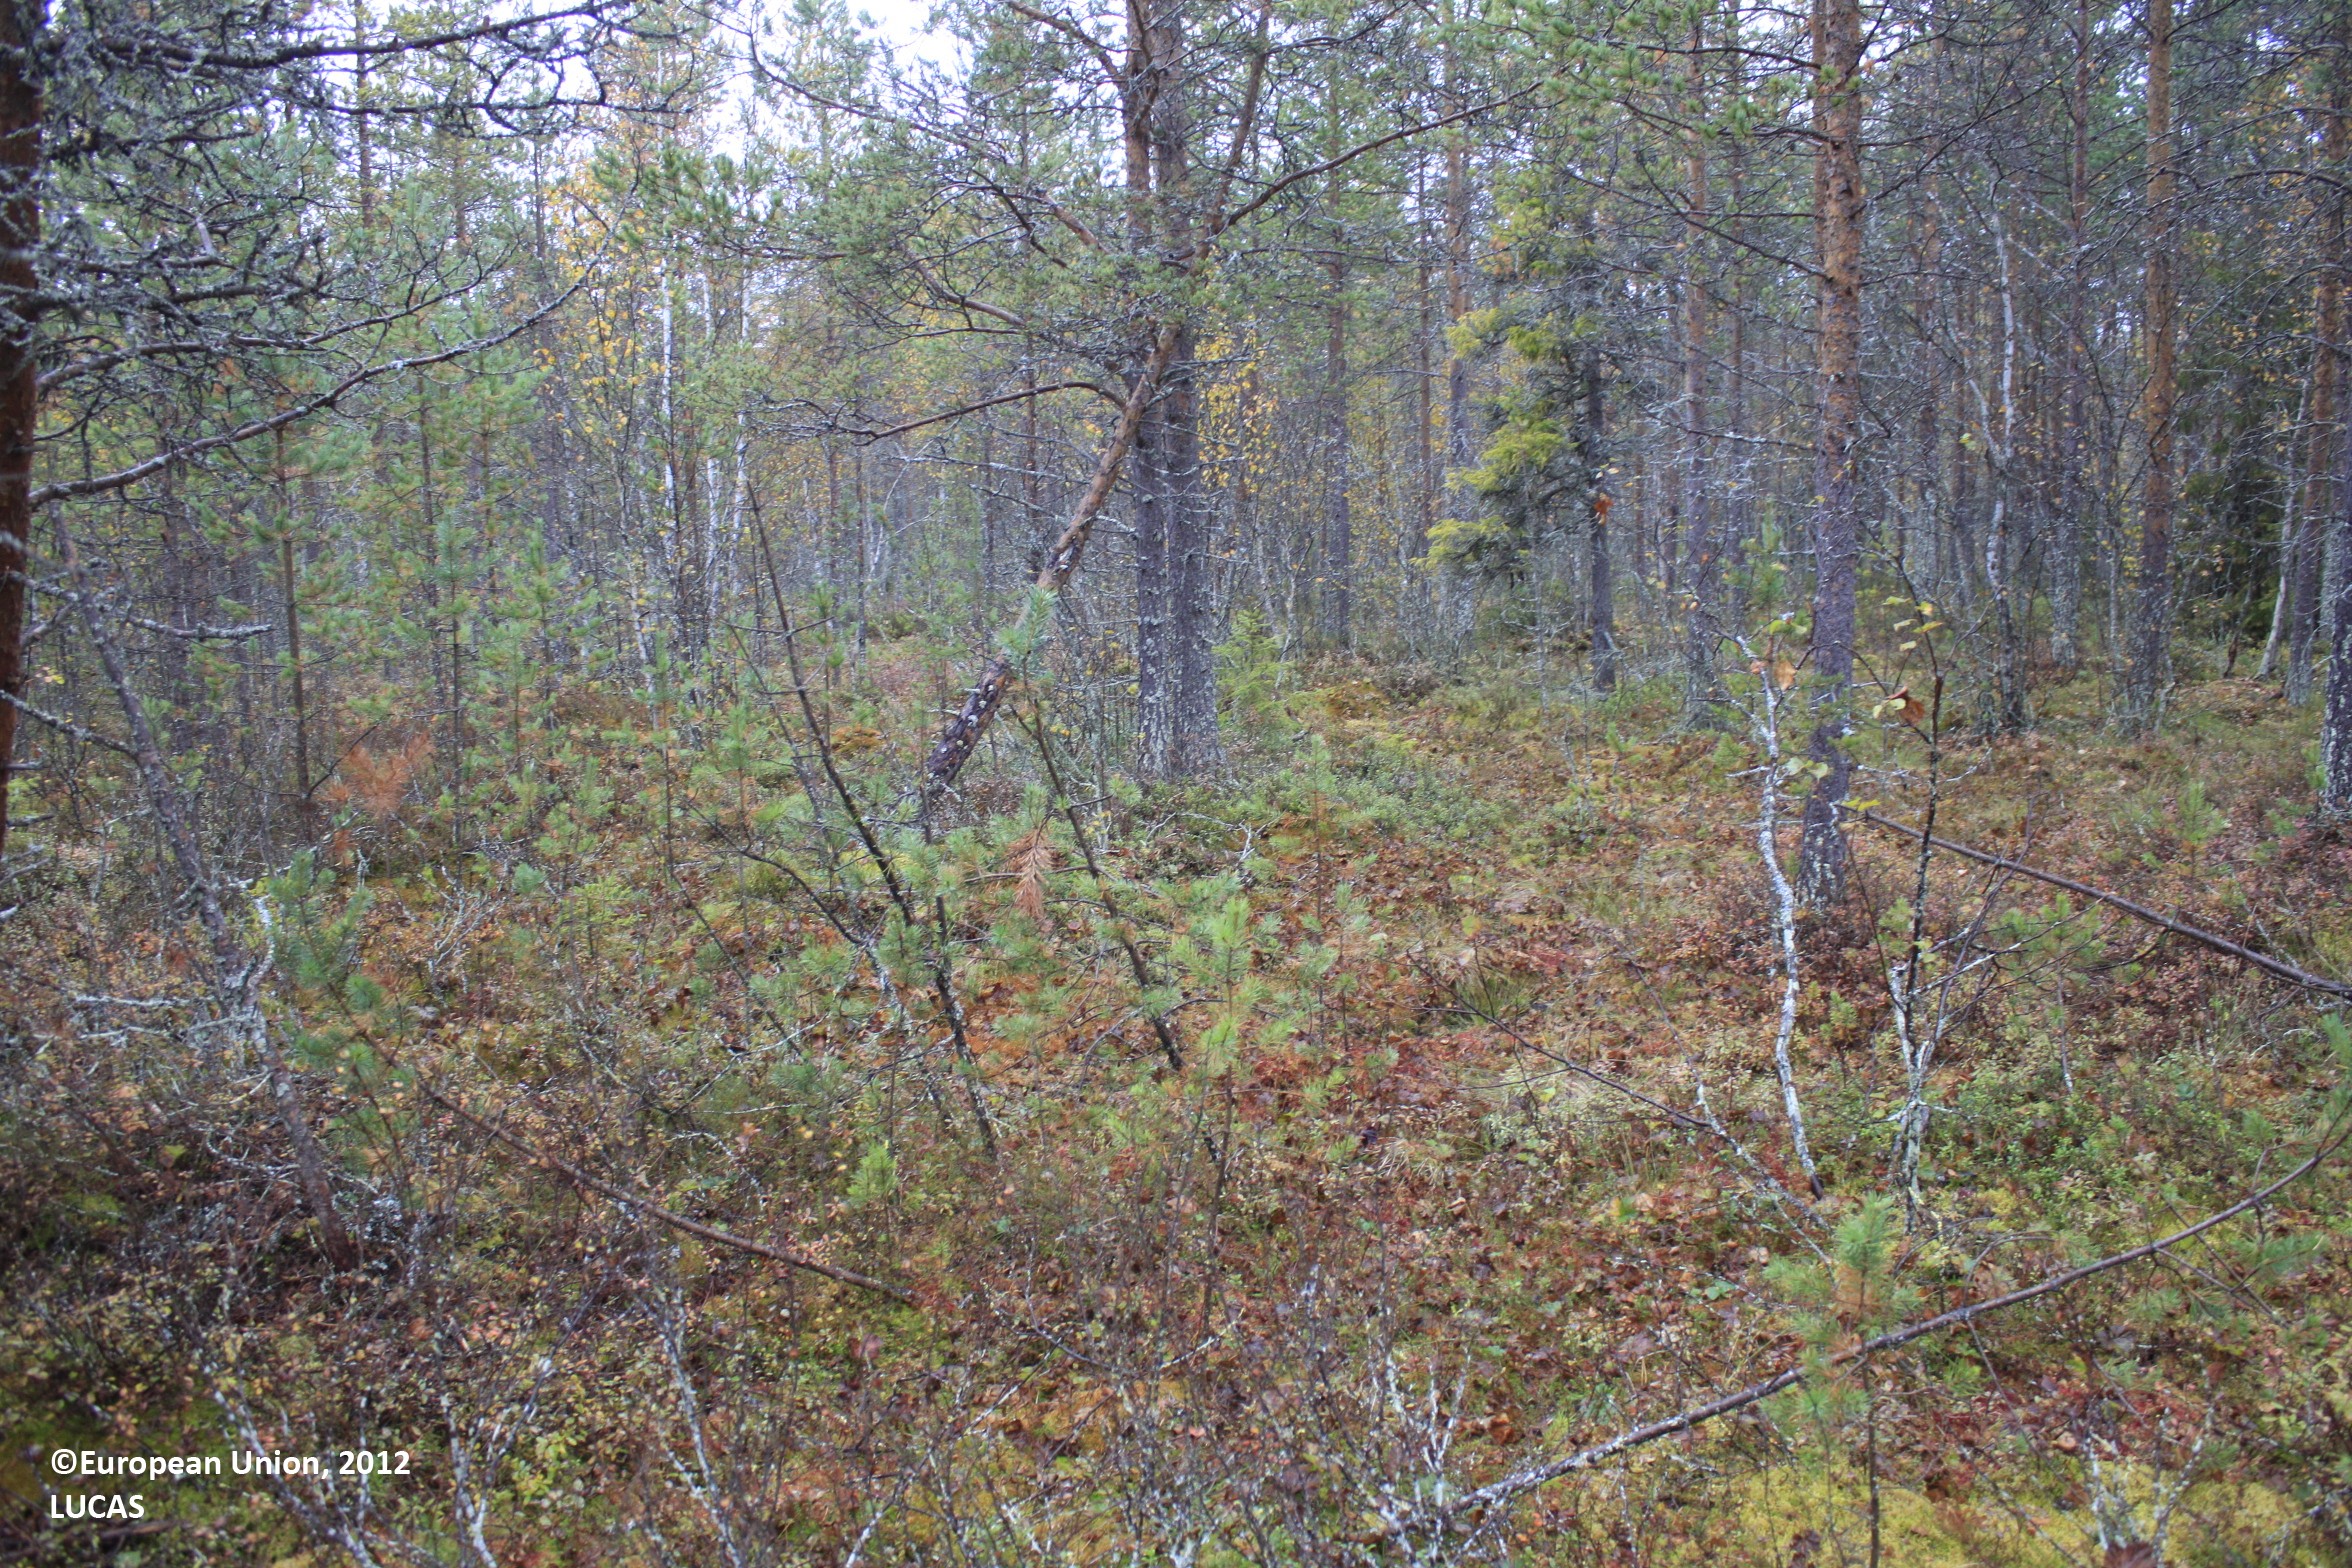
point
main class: Woodland
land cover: Pine dominated mixed woodland
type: mire and swamp forests
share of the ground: 25 - 50 %
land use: Forestry
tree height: > 5 m
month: September
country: FI
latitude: 65.7495
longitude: 27.4264
